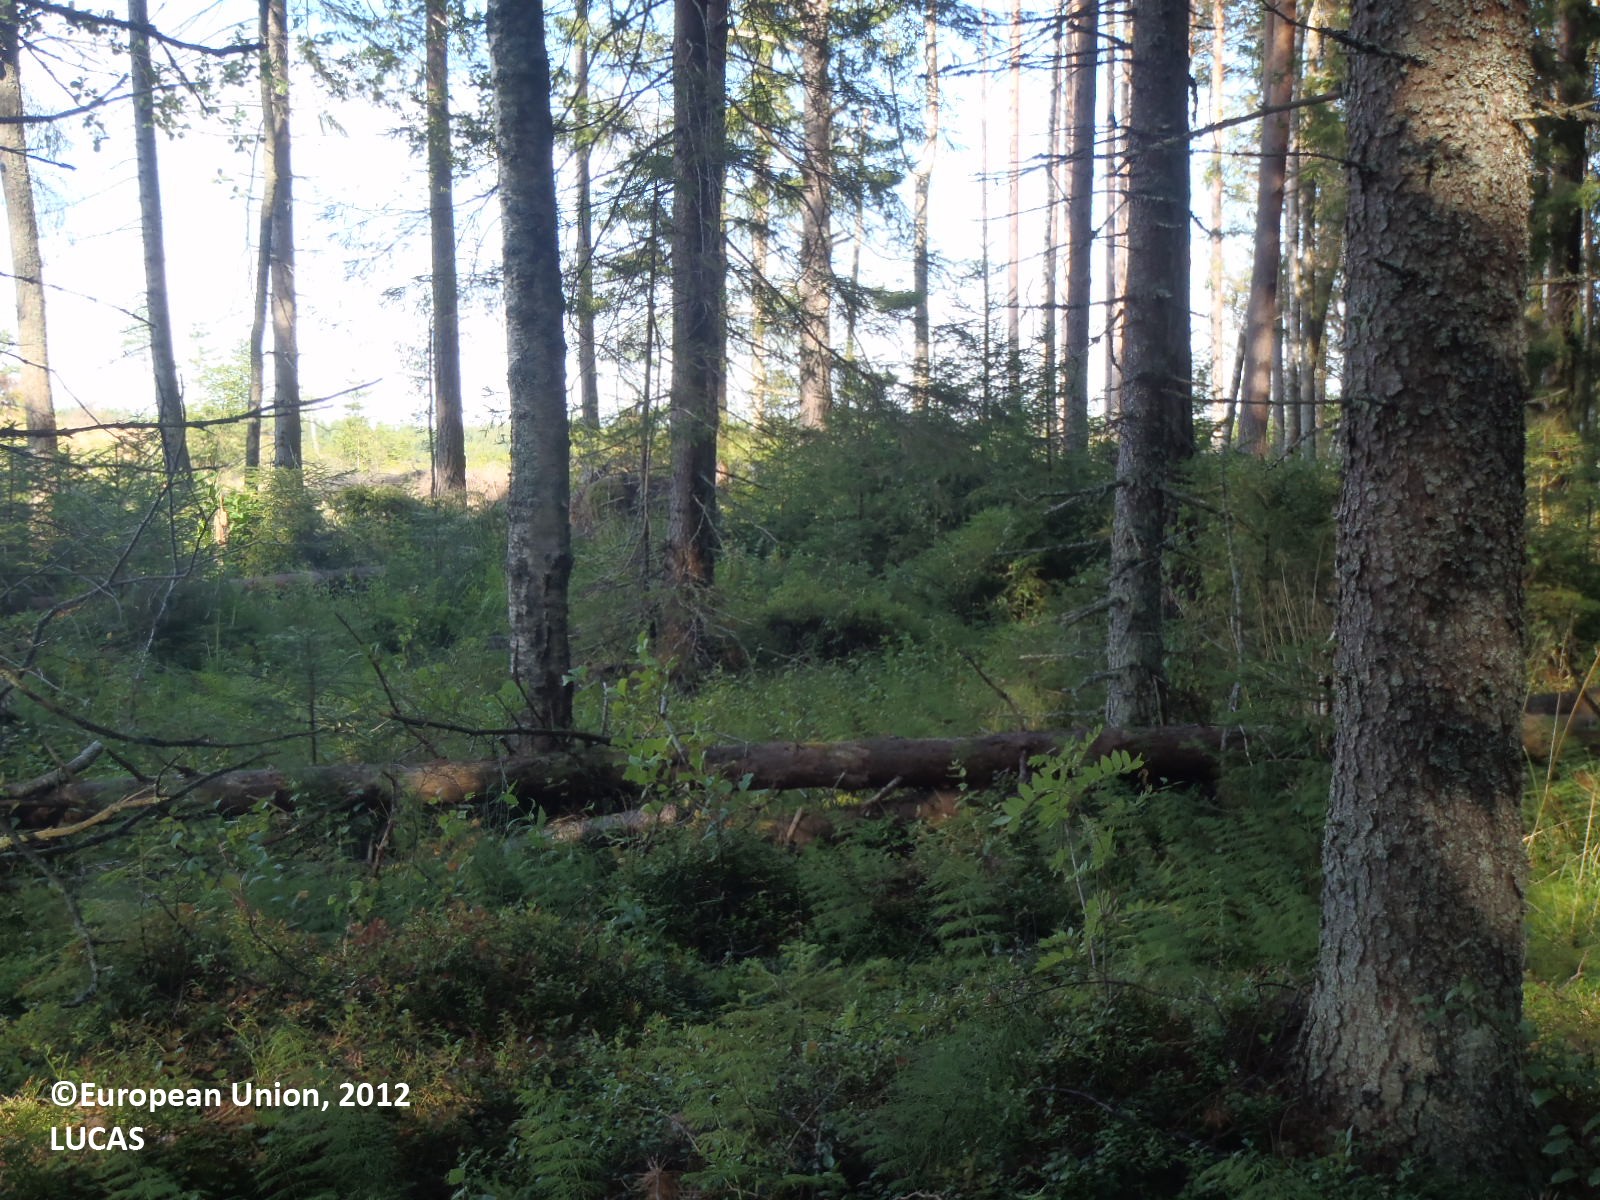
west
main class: Woodland
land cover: Spruce dominated mixed woodland
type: boreal forest
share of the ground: > 75 %
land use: Forestry
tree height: > 5 m
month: August
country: FI
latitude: 60.3292
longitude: 20.0578
